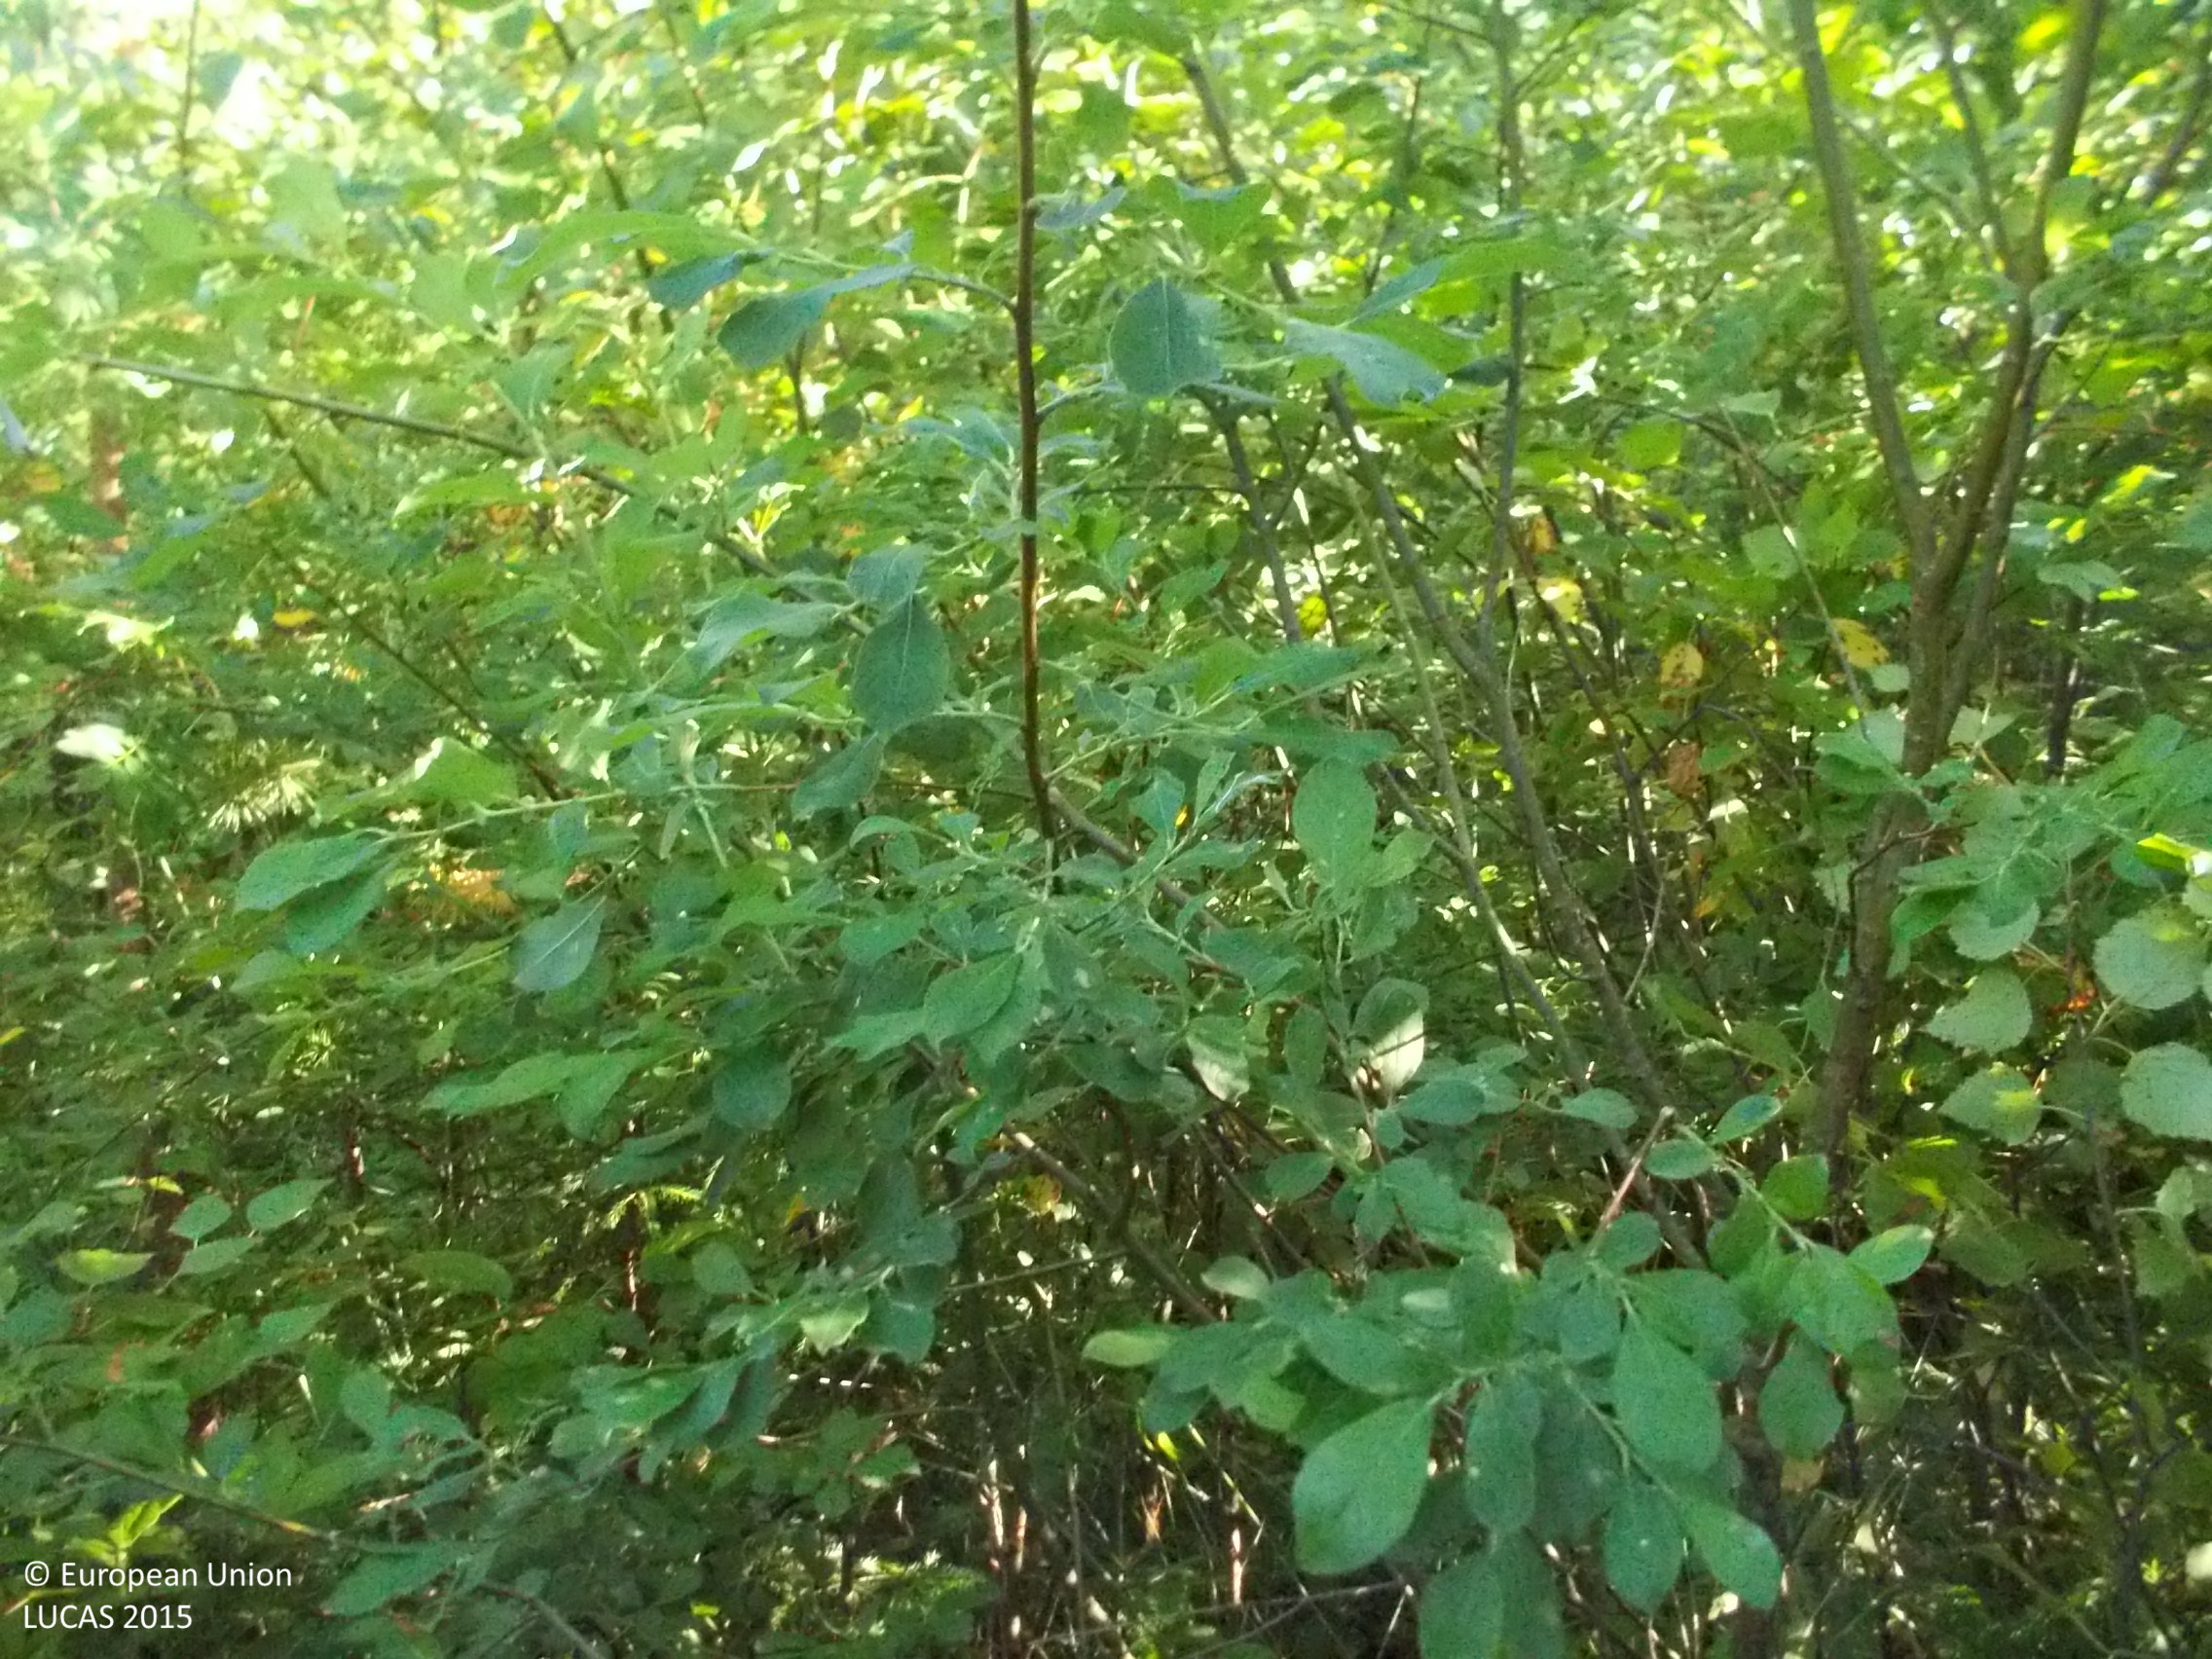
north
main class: Woodland
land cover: Spruce dominated mixed woodland
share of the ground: > 75 %
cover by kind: broadleaved forest trees 60 %, coniferous forest trees 30 %, herbaceous plants 10 %
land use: Forestry
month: August
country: SE
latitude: 57.5681
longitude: 13.2556
